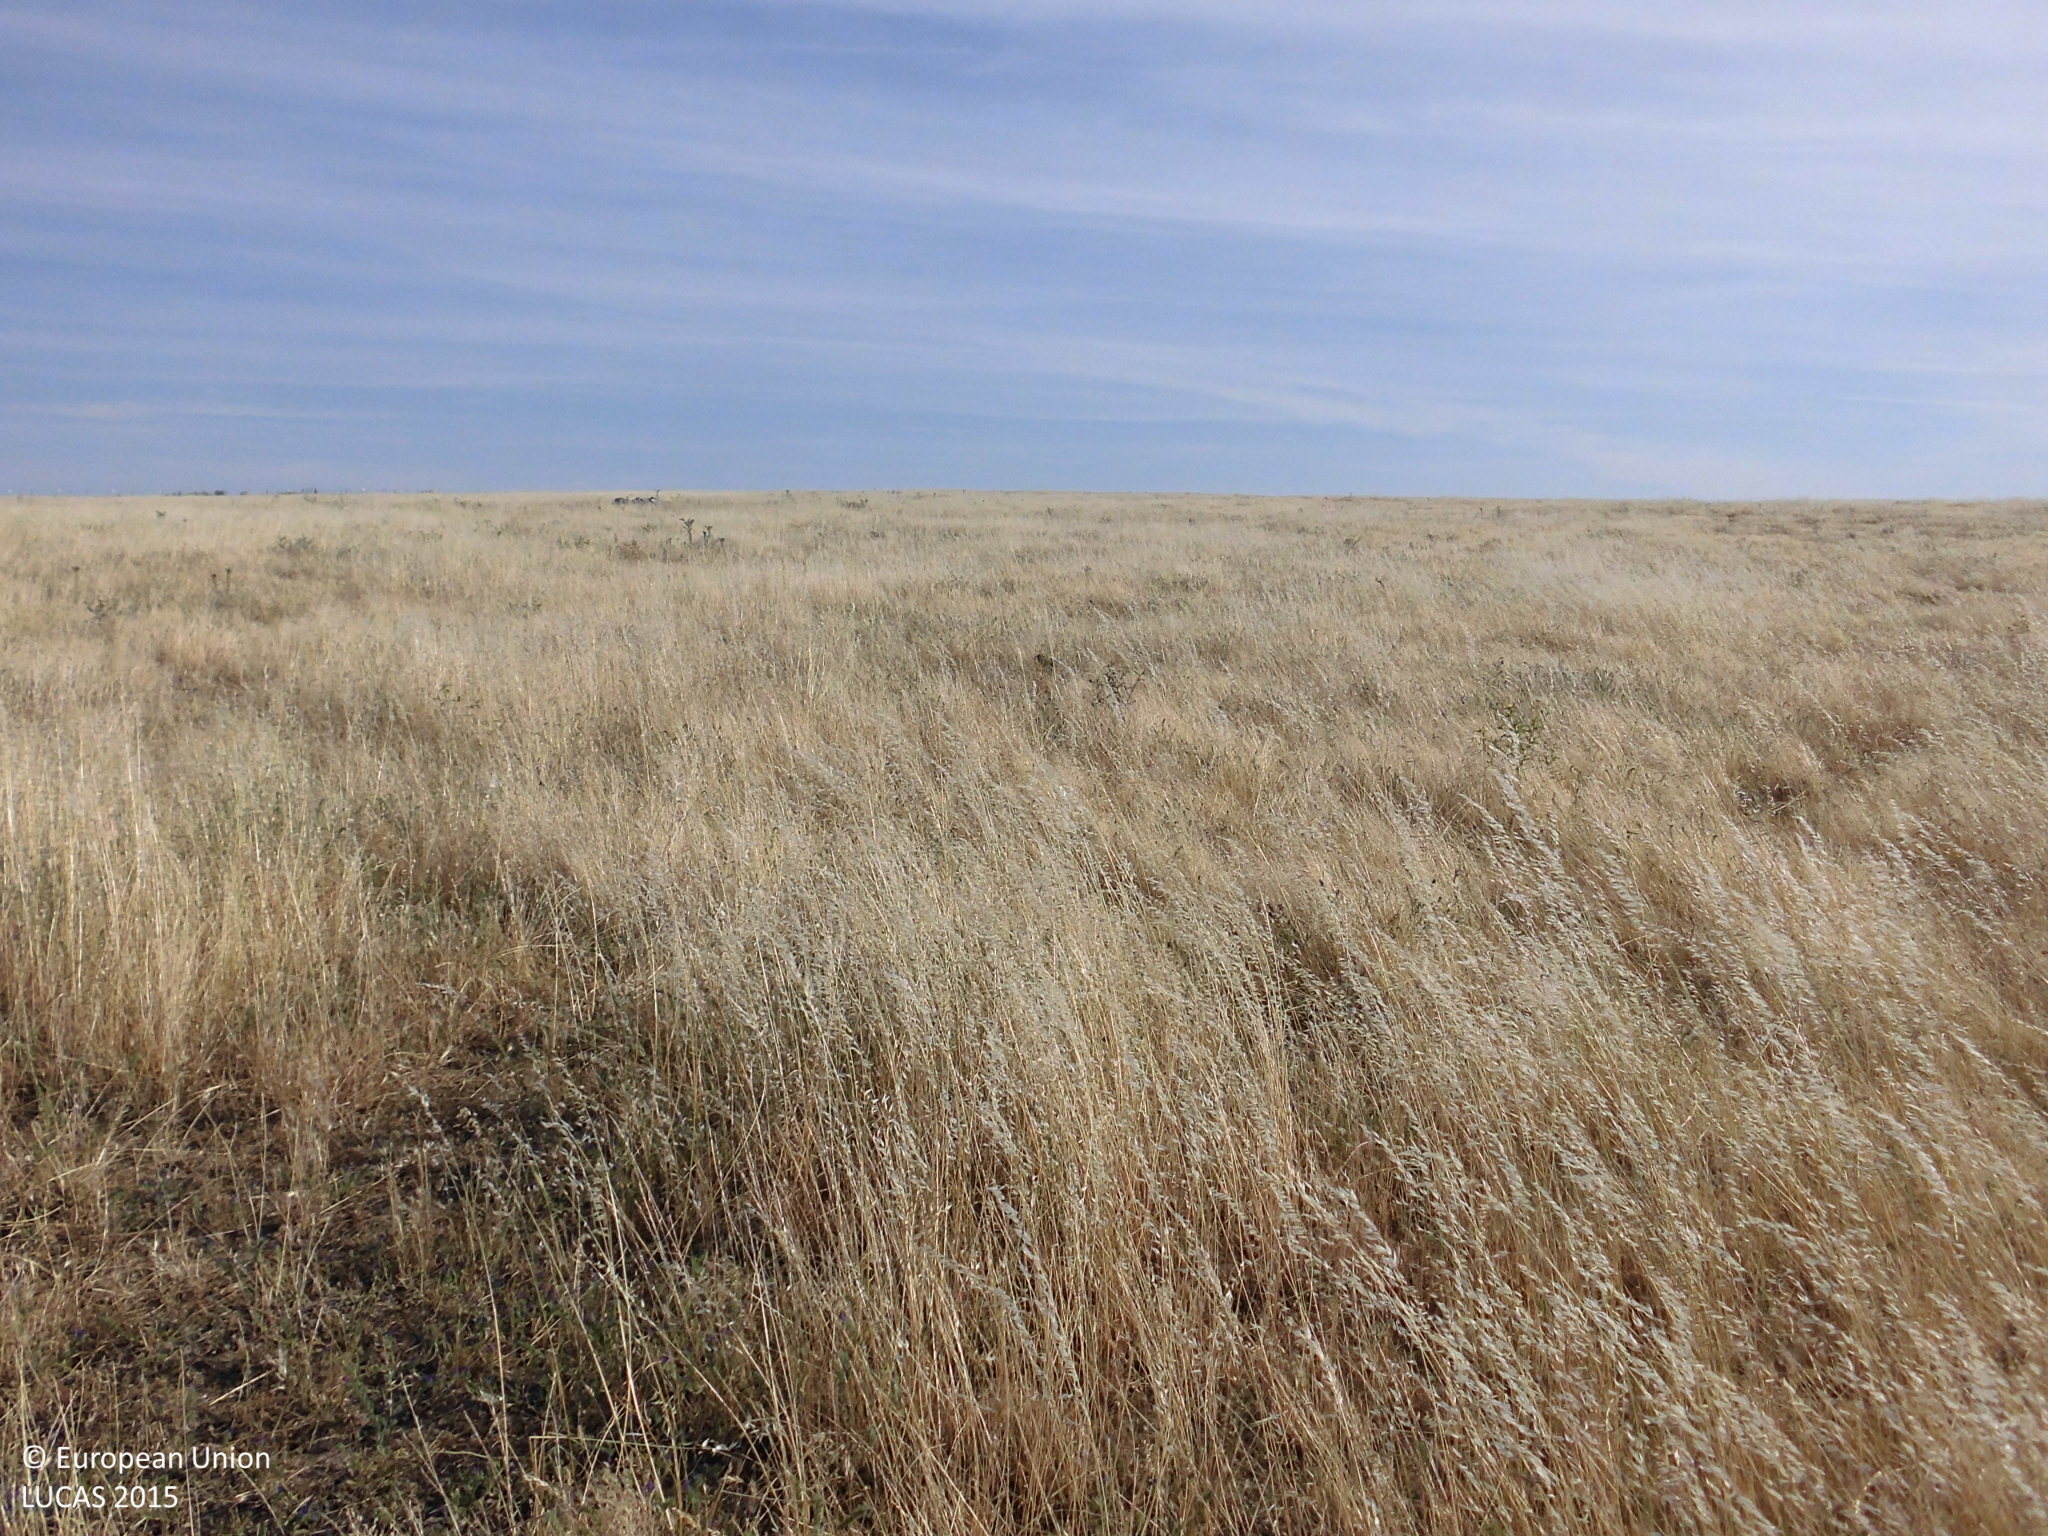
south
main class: Grassland
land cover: Grassland without tree/shrub cover
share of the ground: > 75 %
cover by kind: herbaceous plants 100 %
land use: Agriculture (excluding fallow land and kitchen gardens)
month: May
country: ES
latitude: 39.4962
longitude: -6.0035
